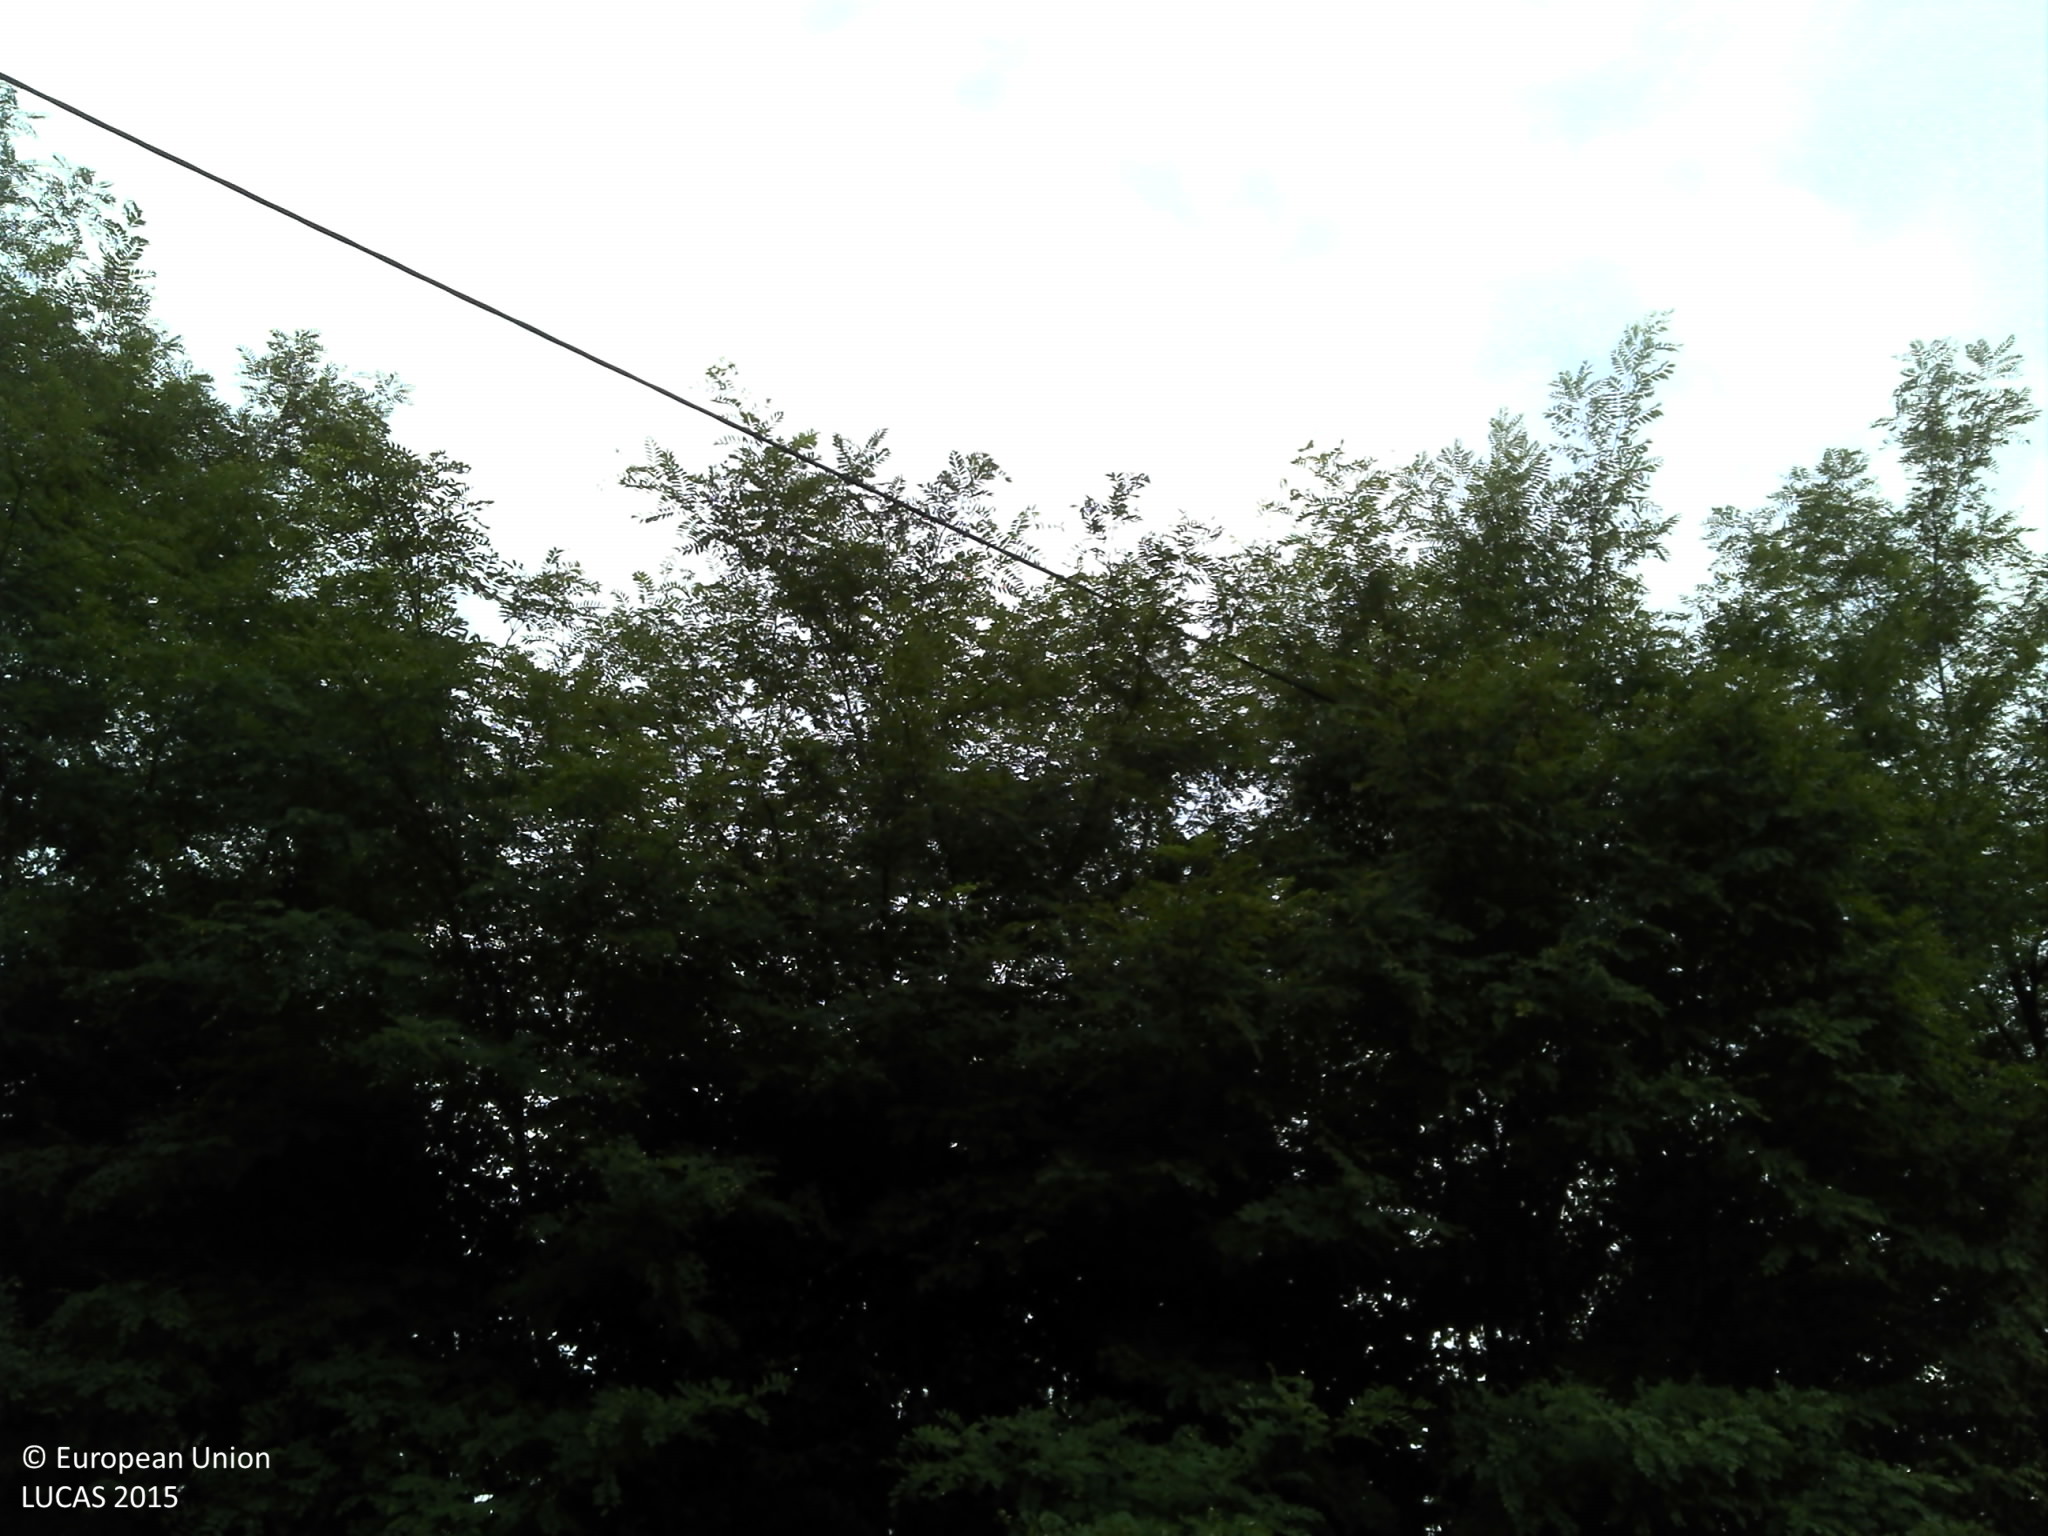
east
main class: Grassland
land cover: Grassland with sparse tree/shrub cover
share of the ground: > 75 %
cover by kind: herbaceous plants 95 %, broadleaved forest trees 5 %
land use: Agriculture (excluding fallow land and kitchen gardens)
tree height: < 5 m
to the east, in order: Grassland with sparse tree/shrub cover; Artificial constructions in urban areas; Lines of trees; Tracks; Lines of trees; Fences; Shrubland with sparse tree cover
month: September
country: HR
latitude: 45.1721
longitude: 15.6577
